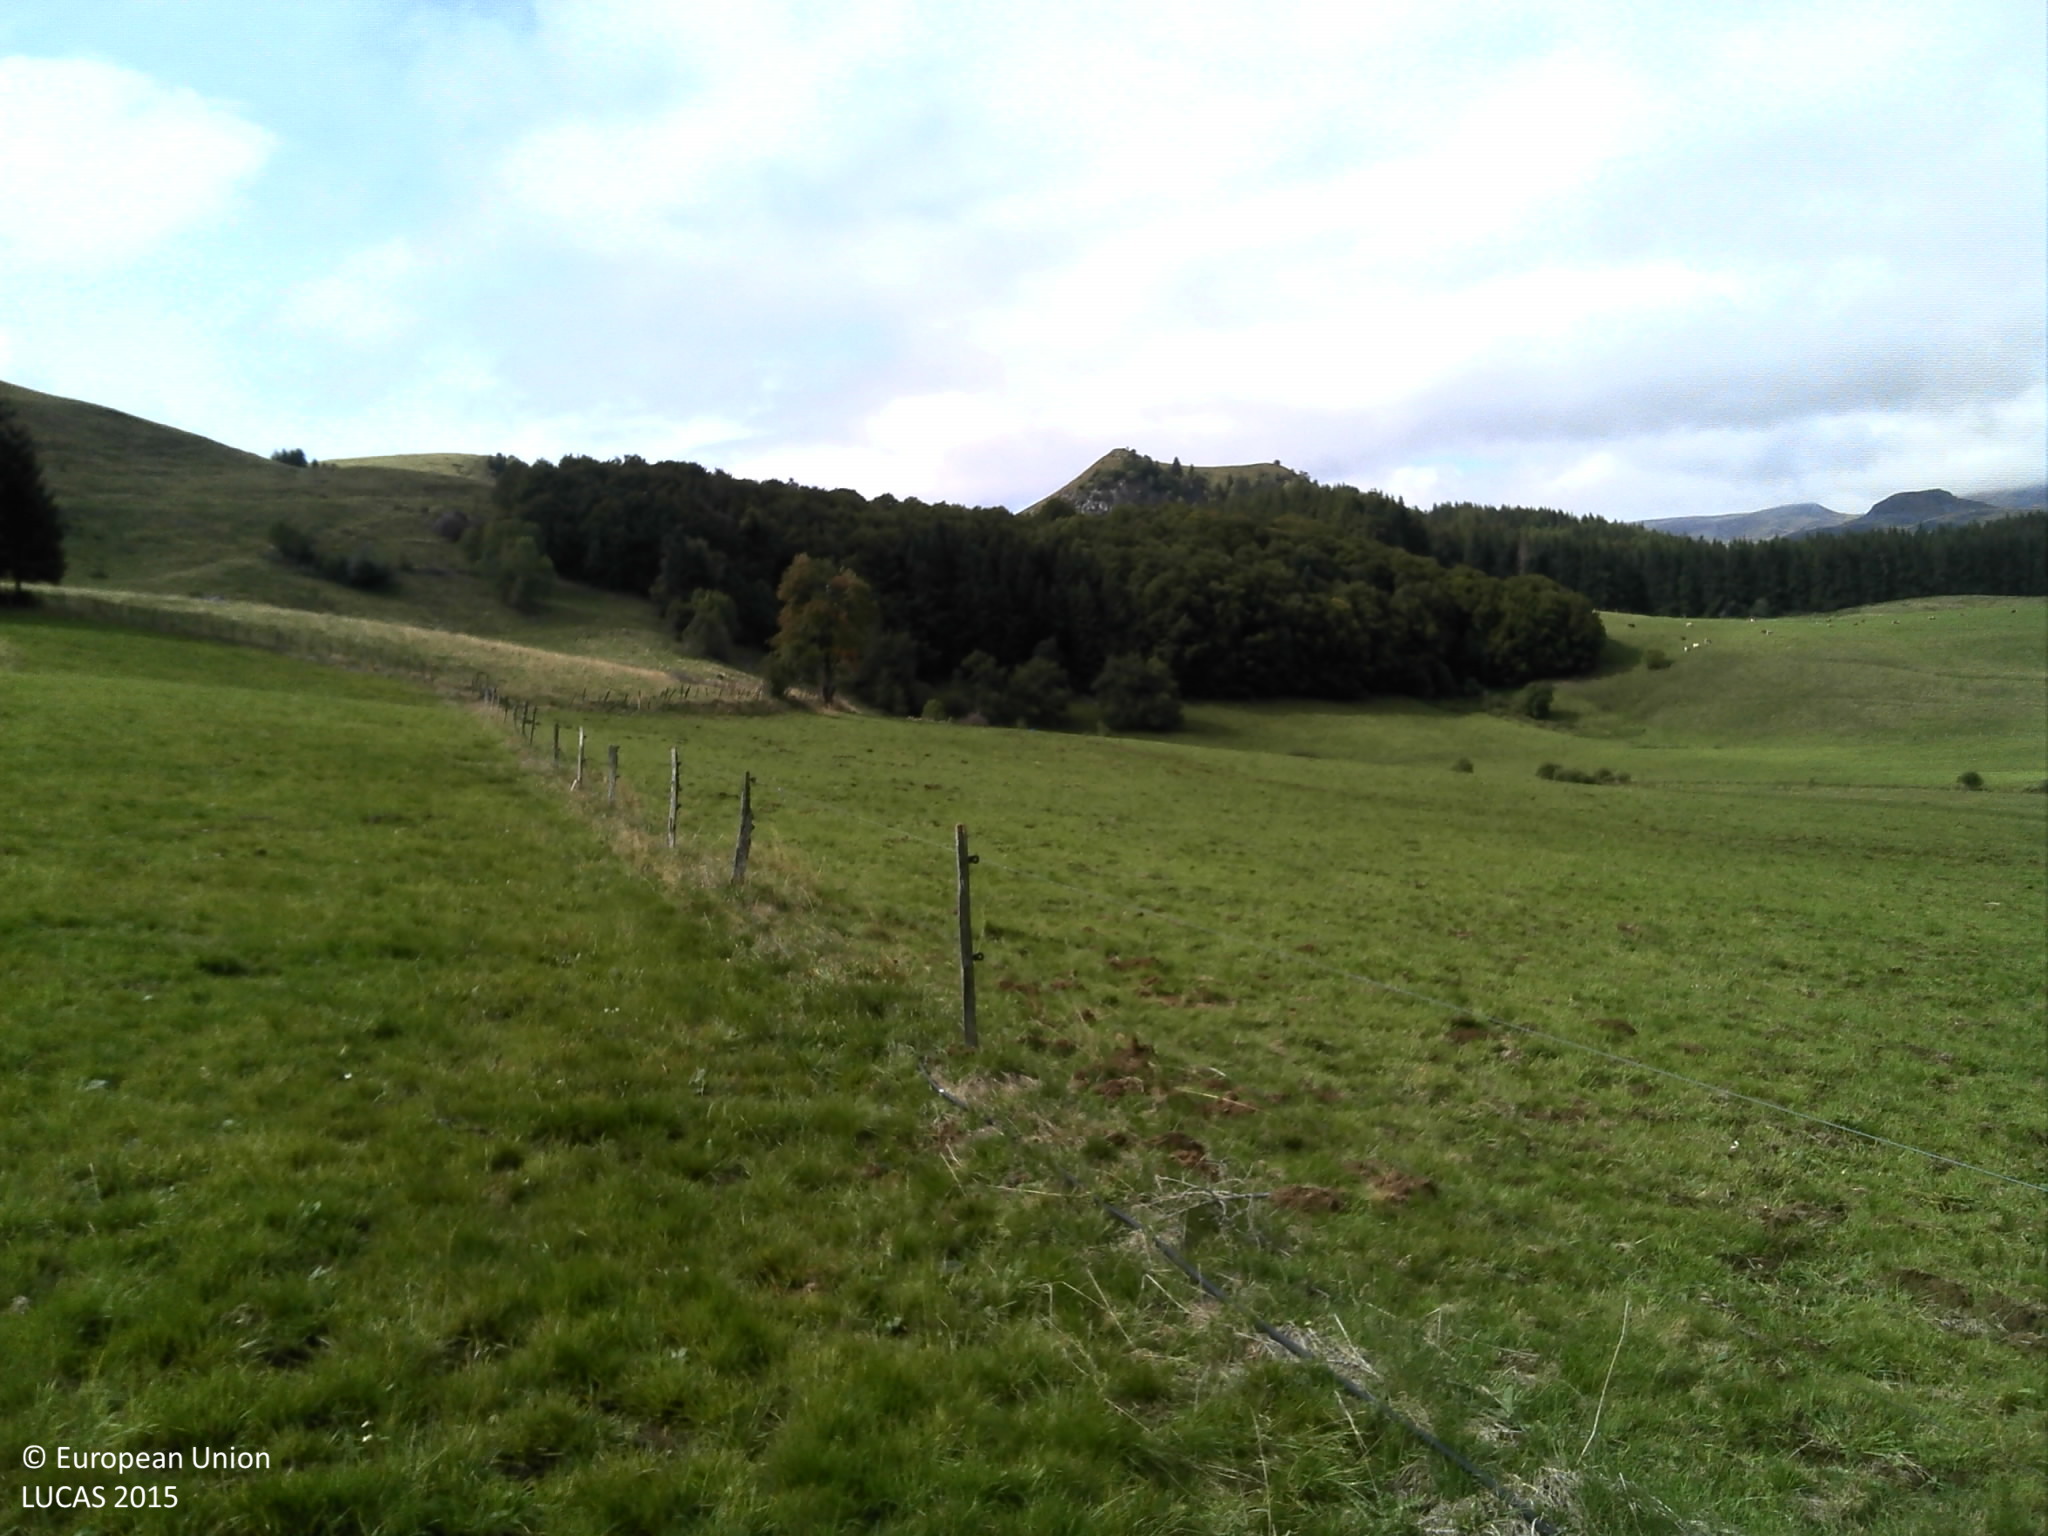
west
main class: Grassland
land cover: Grassland without tree/shrub cover
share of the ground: > 75 %
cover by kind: herbaceous plants 100 %
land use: Agriculture (excluding fallow land and kitchen gardens)
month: September
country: FR
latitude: 45.5019
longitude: 2.9227
